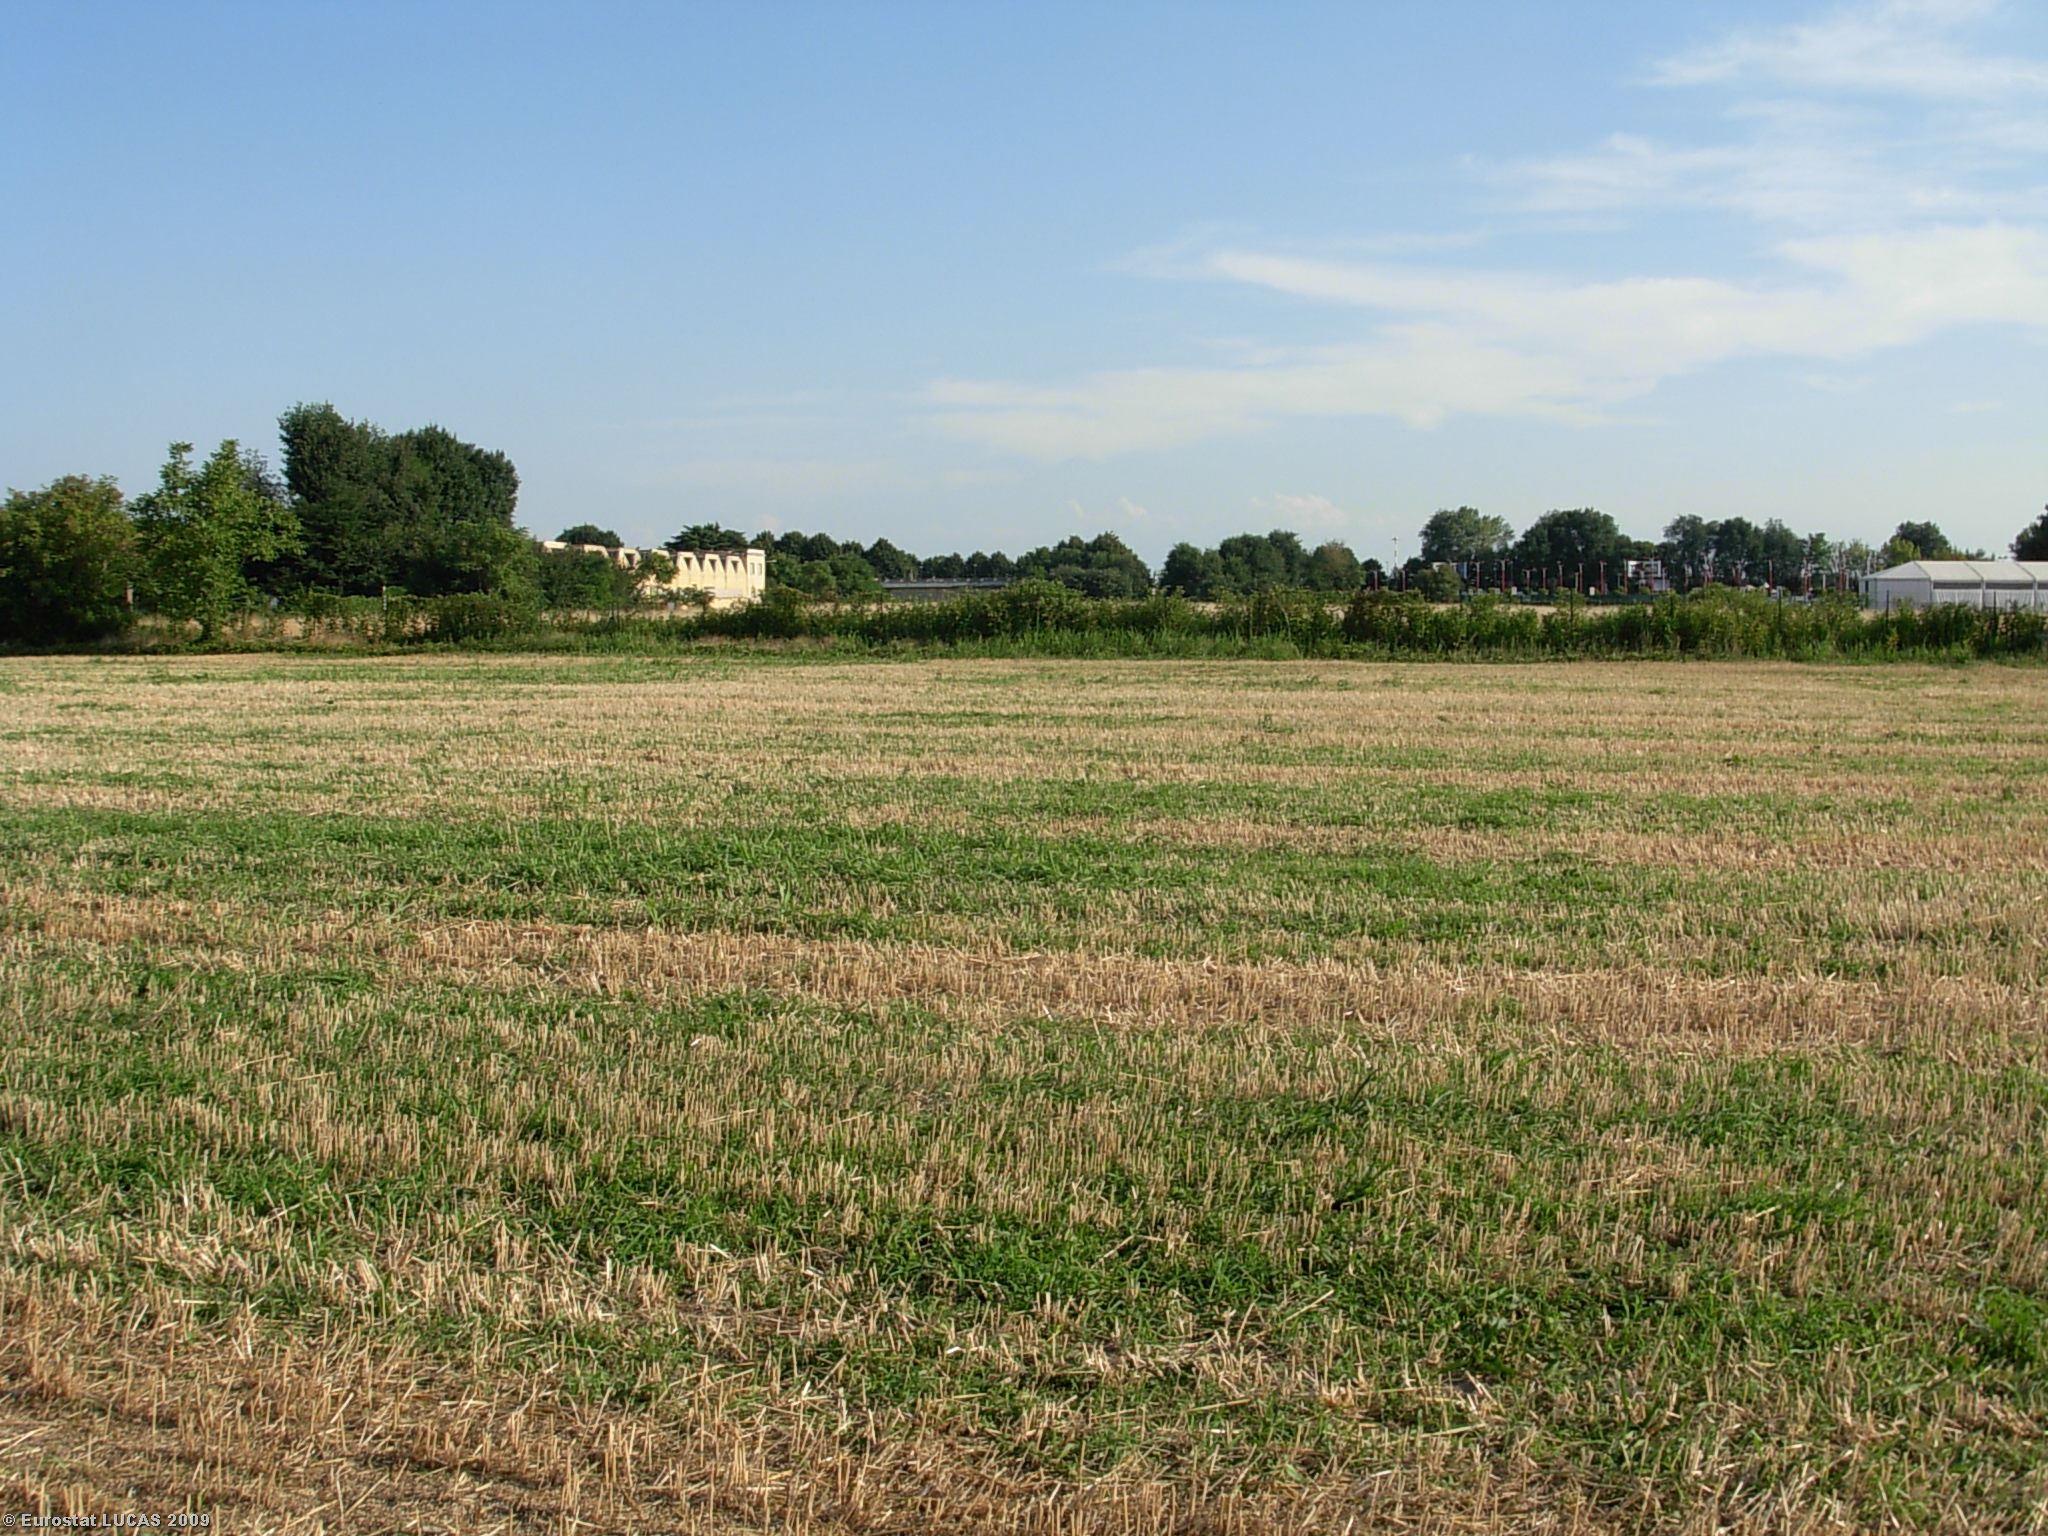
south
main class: Cropland
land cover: Common wheat
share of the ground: < 10 %
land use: Agriculture (excluding fallow land and kitchen gardens)
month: July
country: IT
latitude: 45.4659
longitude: 9.2722
